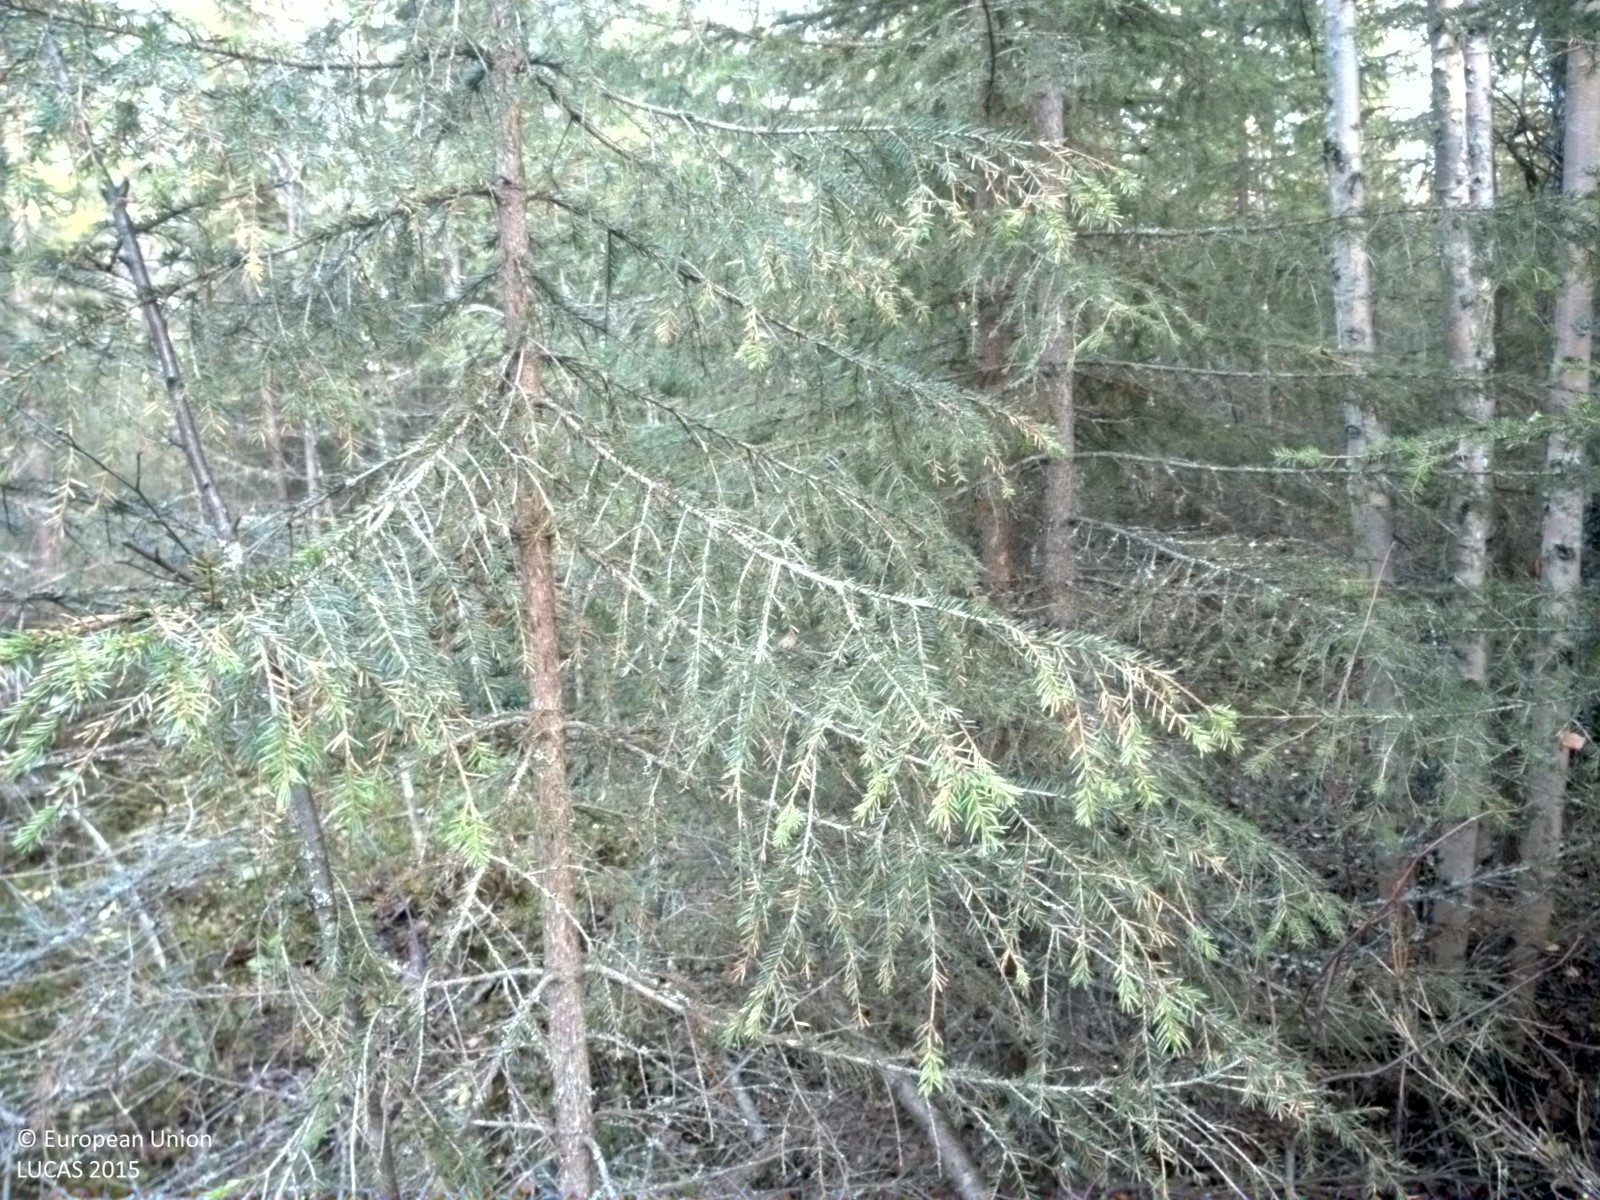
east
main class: Woodland
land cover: Spruce dominated mixed woodland
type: boreal forest
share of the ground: 50 - 75 %
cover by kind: coniferous forest trees 40 %, shrubs 35 %, broadleaved forest trees 25 %
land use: Forestry
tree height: > 5 m
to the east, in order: Spruce dominated mixed woodland
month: October
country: SE
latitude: 65.9974
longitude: 22.2023
